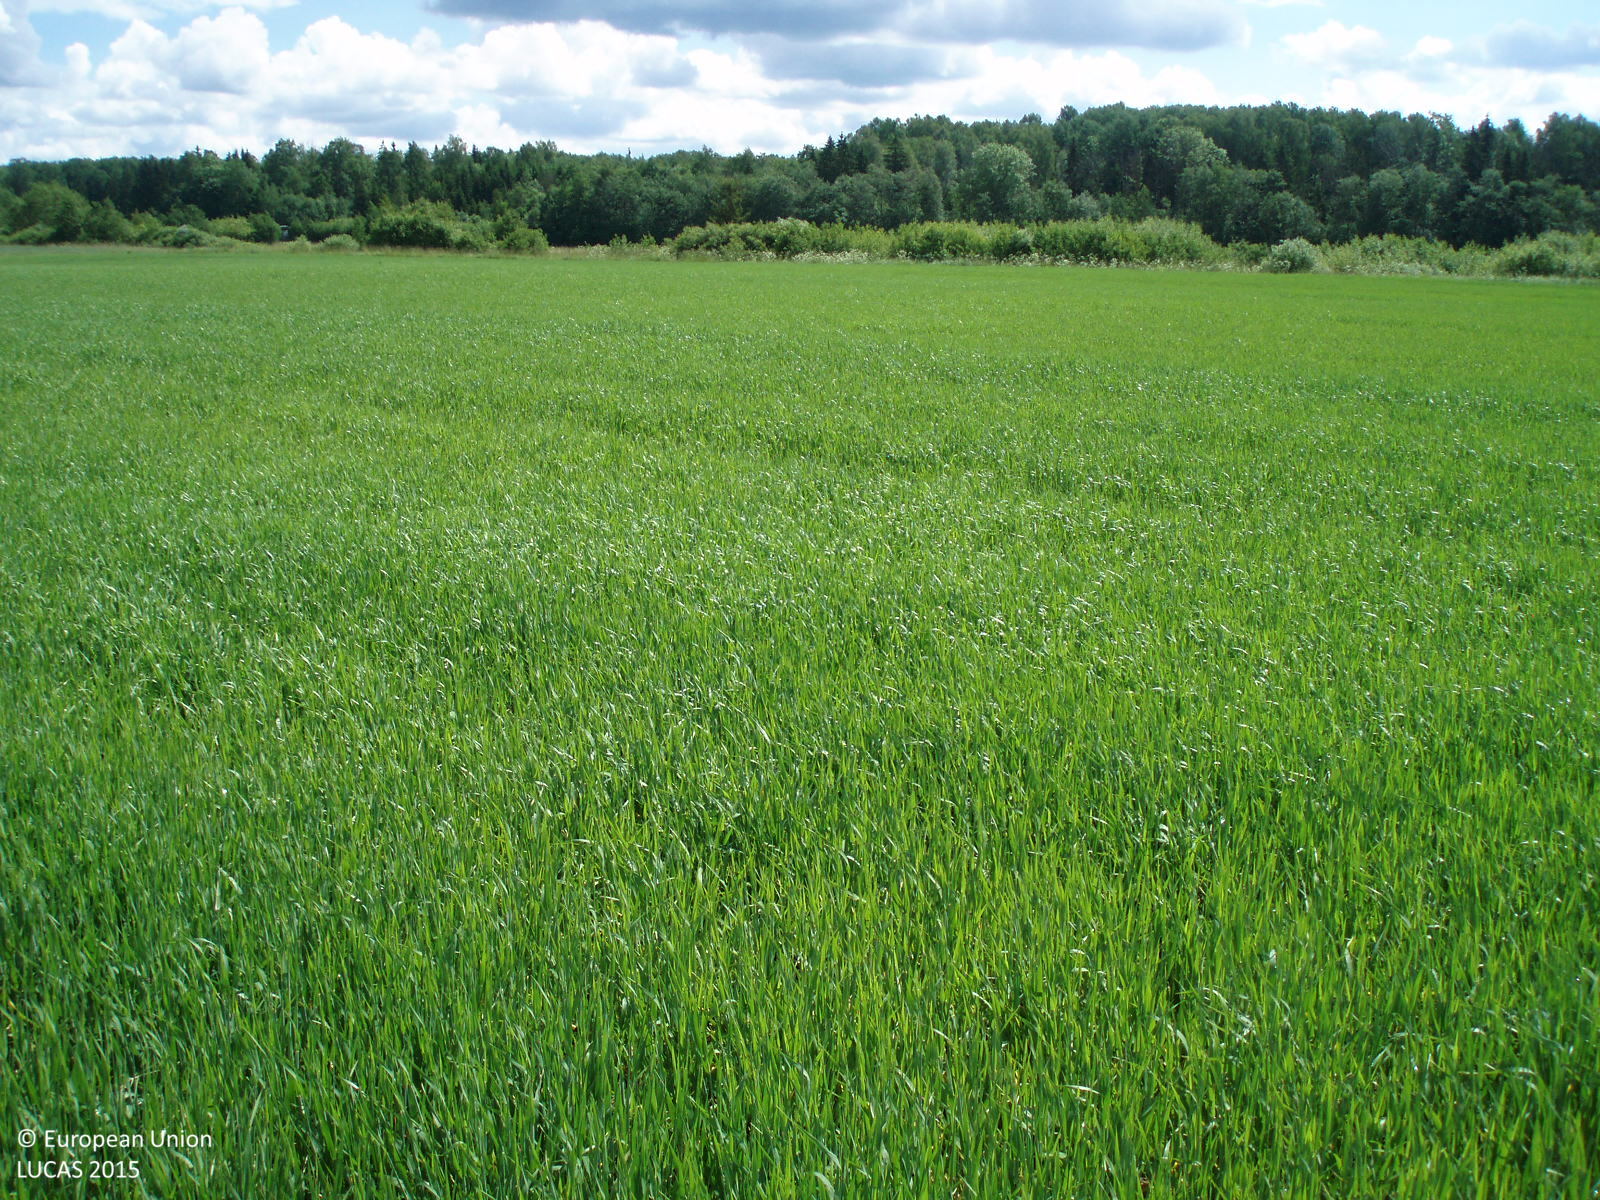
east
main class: Cropland
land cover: Barley
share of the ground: > 75 %
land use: Agriculture (excluding fallow land and kitchen gardens)
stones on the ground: < 10 %
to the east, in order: Barley; Shrubland without tree cover; Tracks; Barley
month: June
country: LT
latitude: 56.2619
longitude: 23.2614
